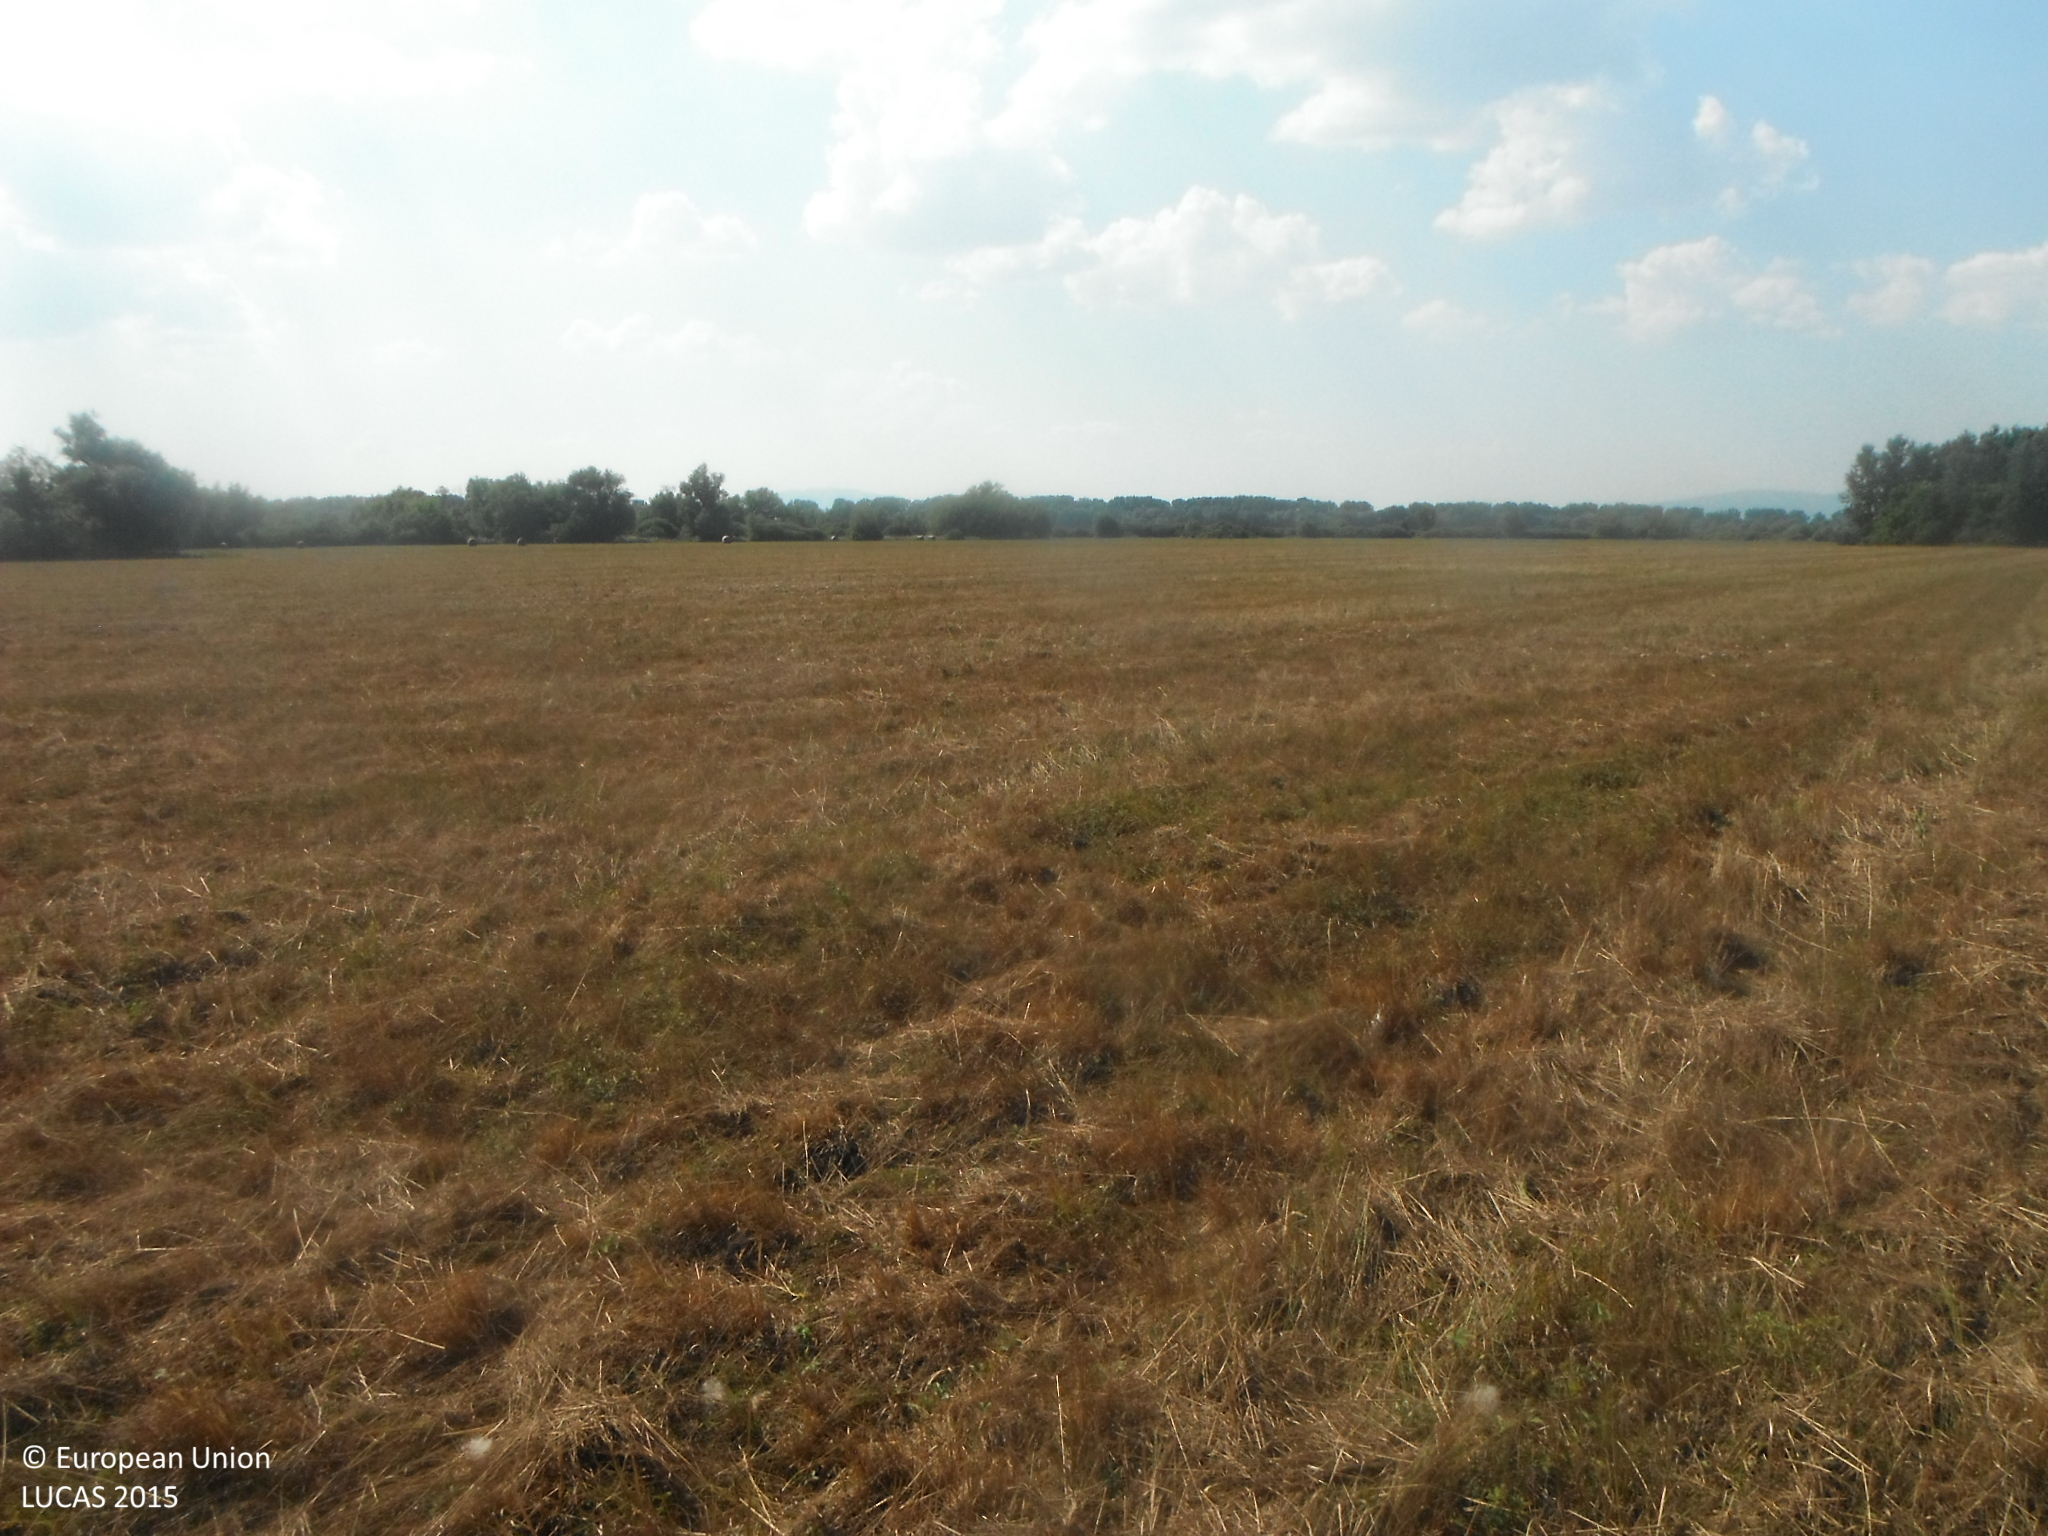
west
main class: Grassland
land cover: Grassland without tree/shrub cover
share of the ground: > 75 %
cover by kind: herbaceous plants 100 %
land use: Agriculture (excluding fallow land and kitchen gardens)
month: August
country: SK
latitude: 48.5484
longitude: 21.8237
